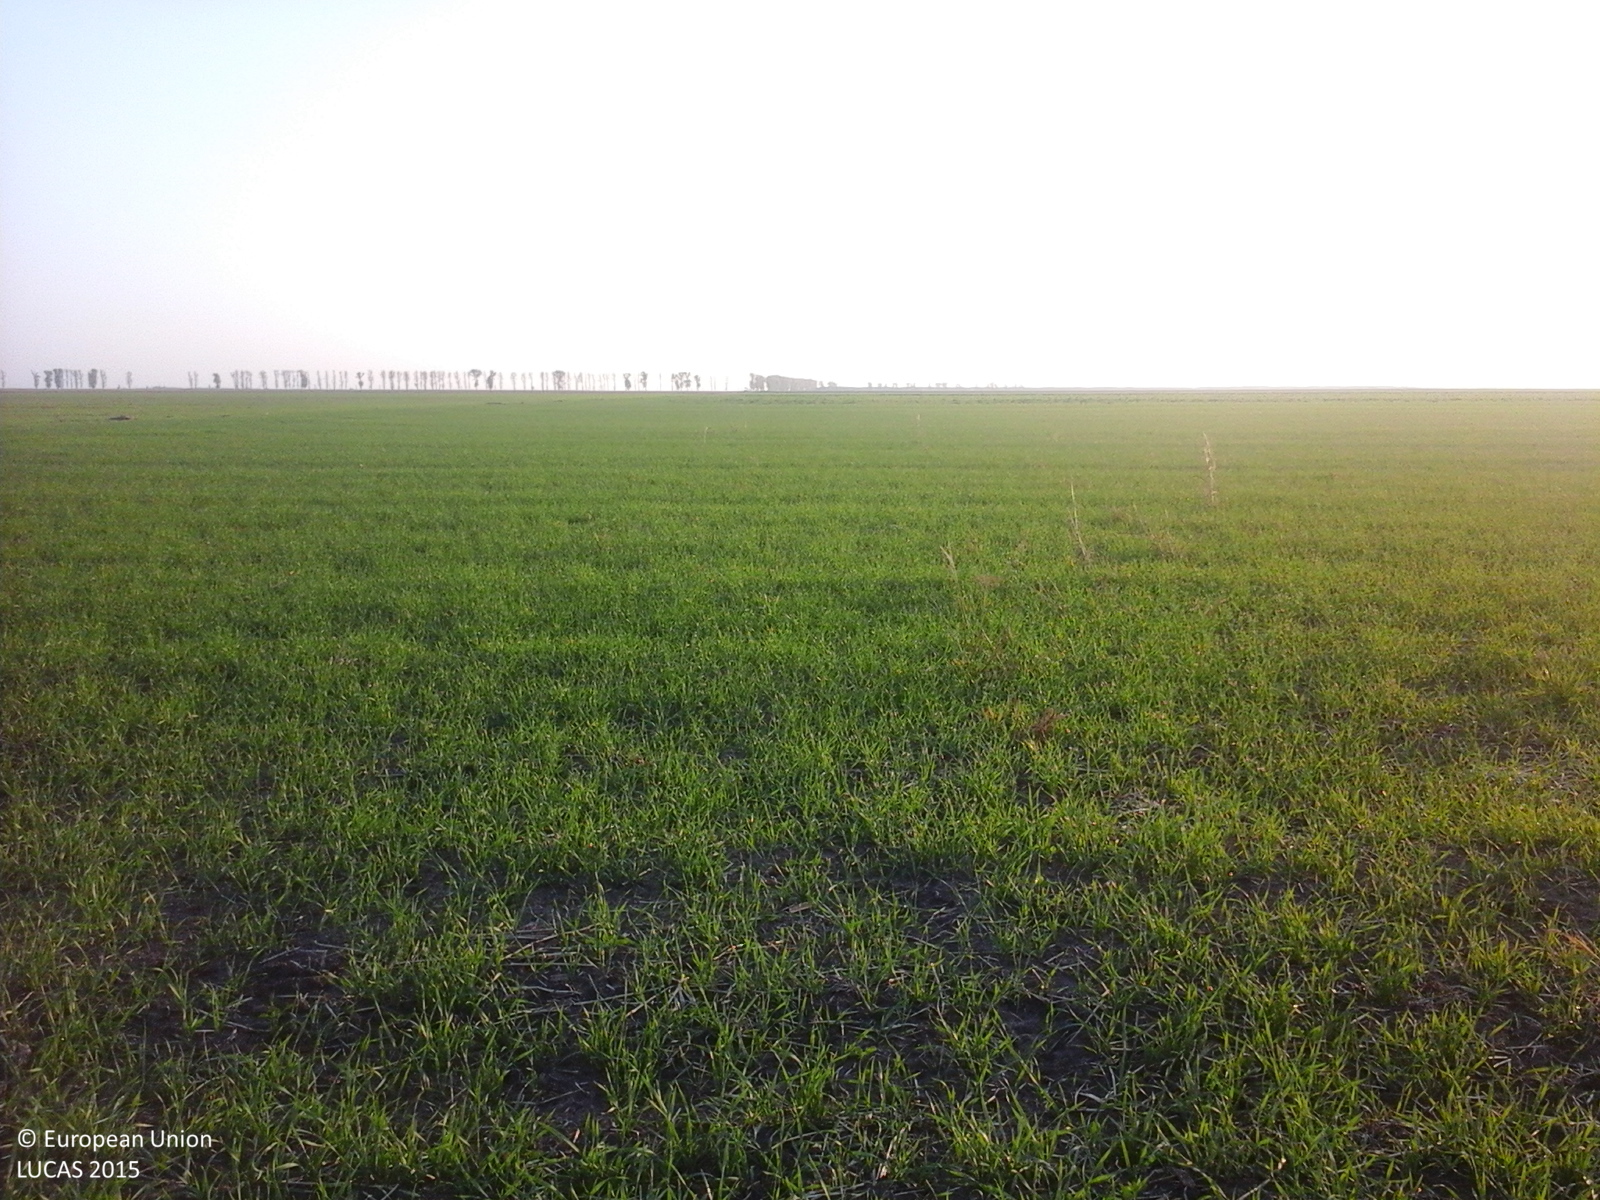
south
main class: Cropland
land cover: Common wheat
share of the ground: > 75 %
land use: Agriculture (excluding fallow land and kitchen gardens)
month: October
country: RO
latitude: 45.2327
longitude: 27.0141
